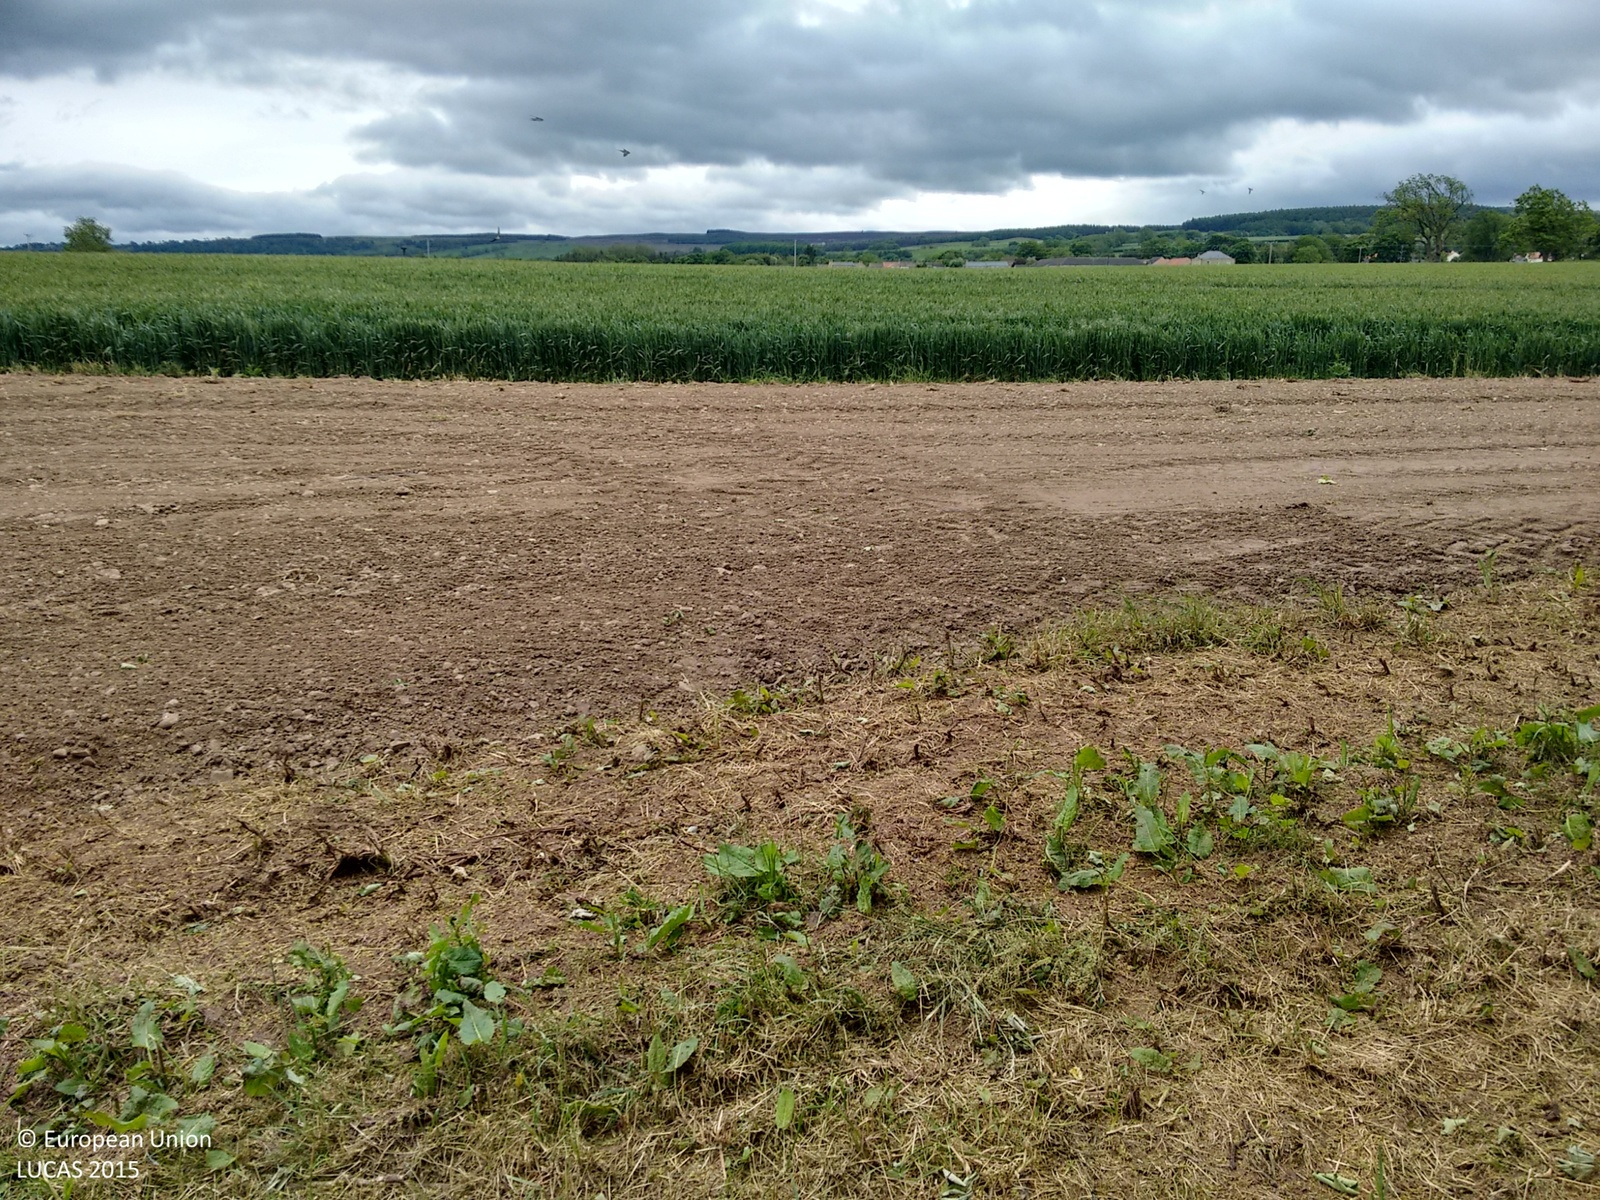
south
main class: Grassland
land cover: Spontaneously vegetated surfaces
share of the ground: > 75 %
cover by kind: herbaceous plants 100 %
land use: Agriculture (excluding fallow land and kitchen gardens)
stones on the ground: > 50 %
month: June
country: GB
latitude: 54.4921
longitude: -1.8328
